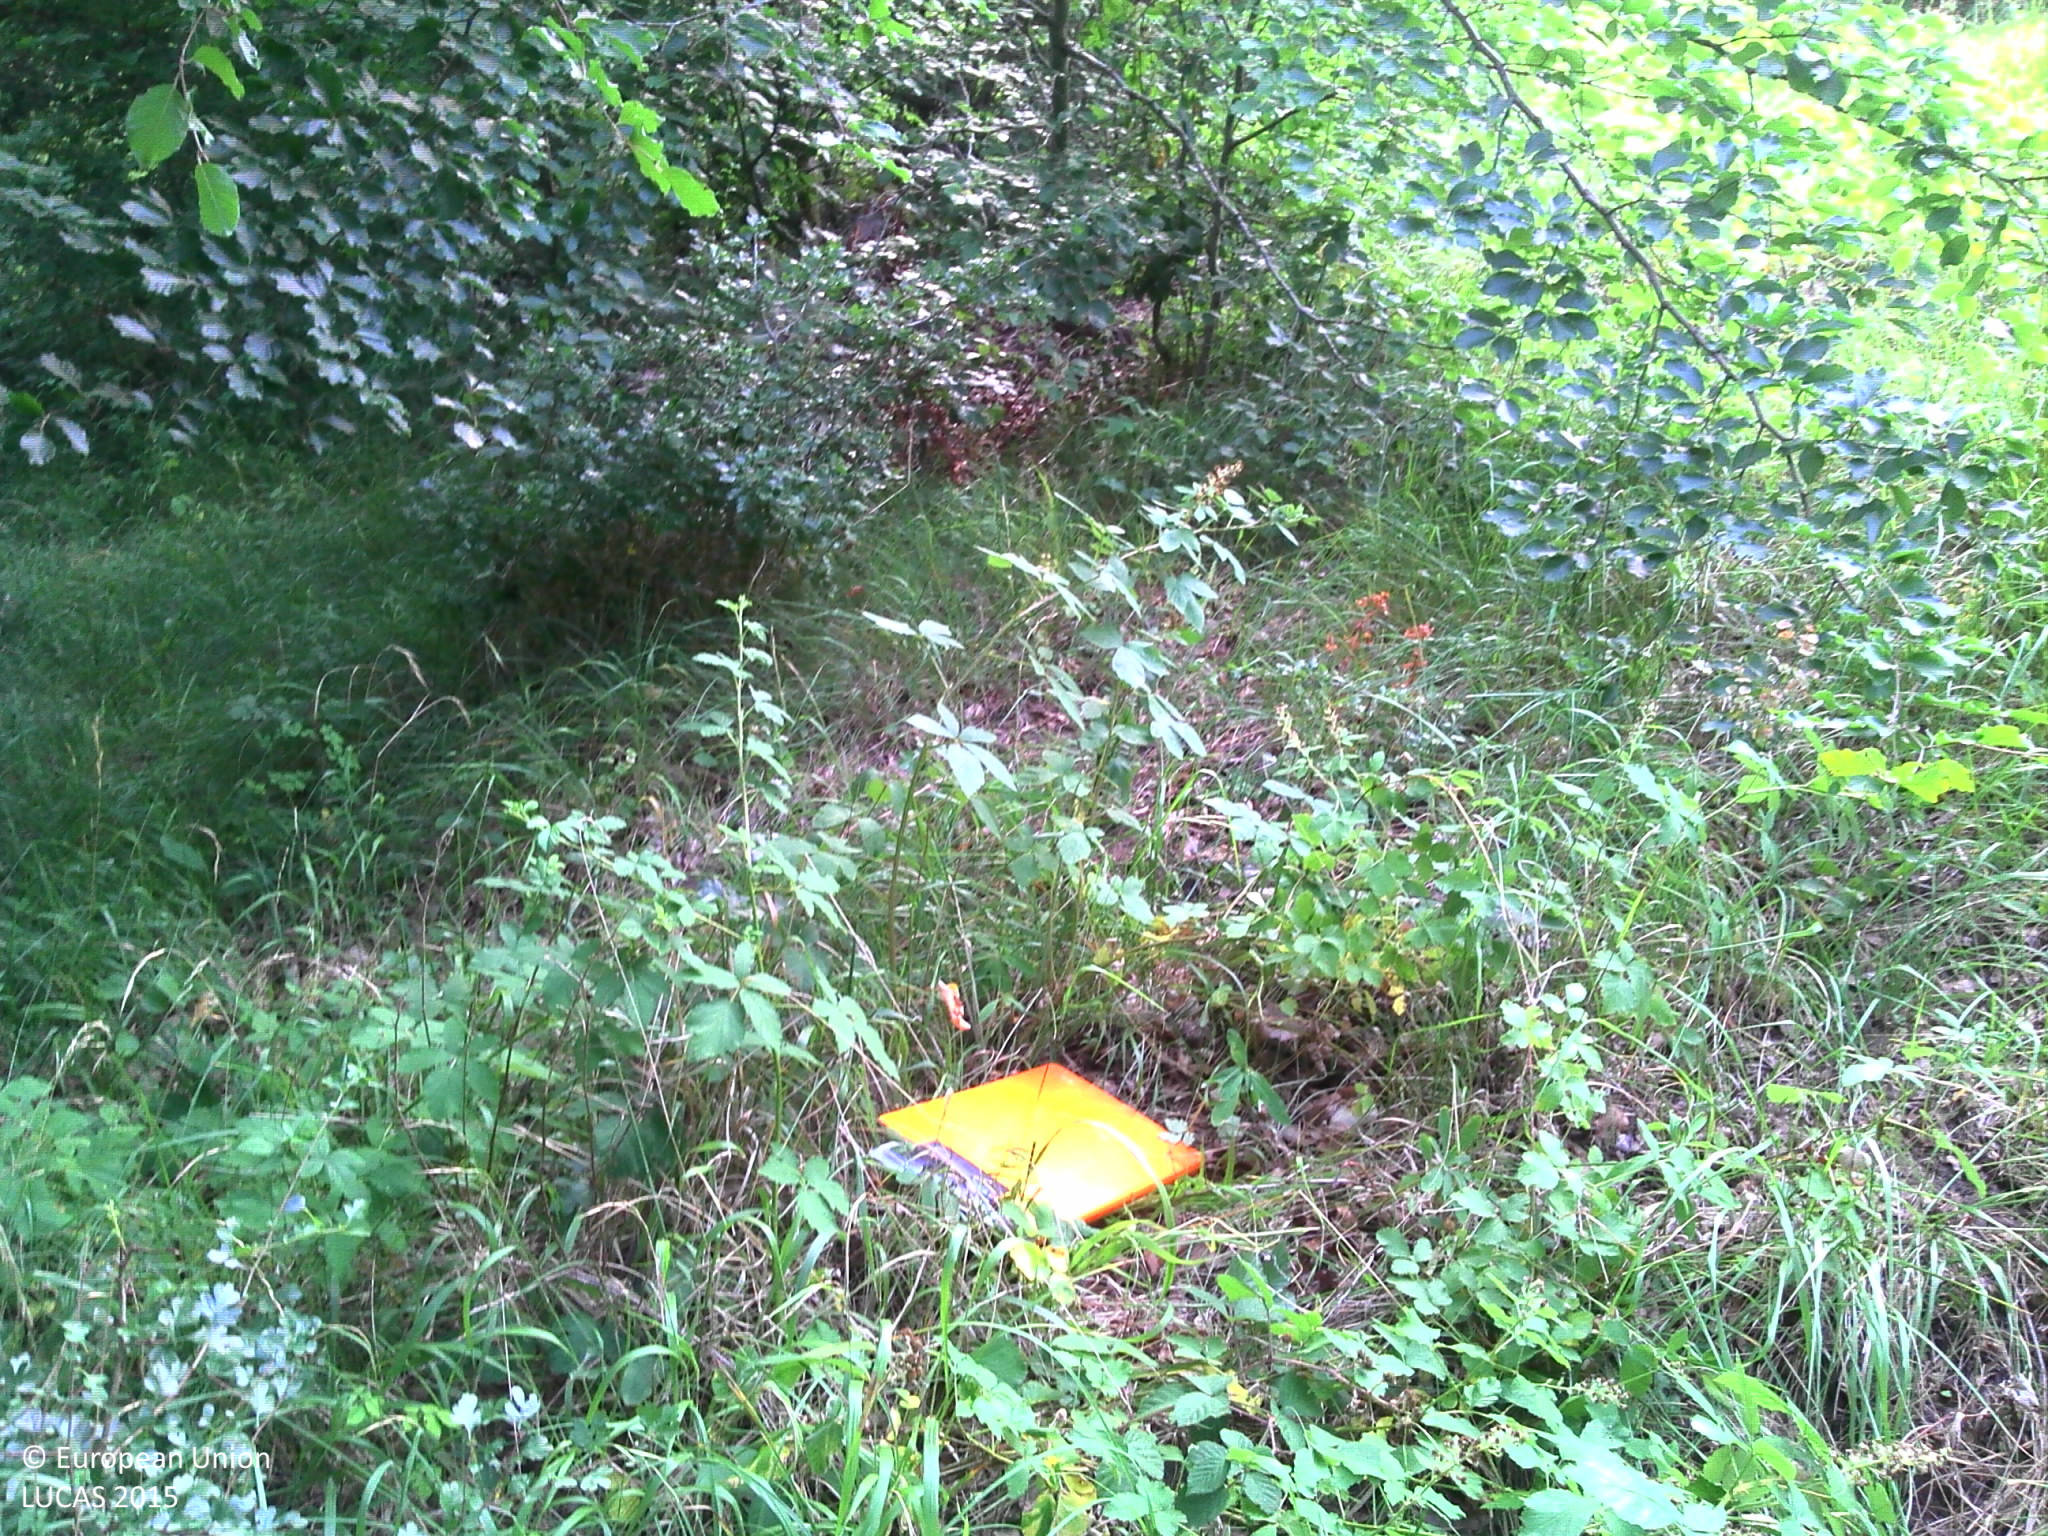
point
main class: Woodland
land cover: Broadleaved woodland
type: beech forest
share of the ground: > 75 %
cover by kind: broadleaved forest trees 80 %, herbaceous plants 15 %, lichens and mosses 5 %
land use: Forestry
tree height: > 5 m
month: July
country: FR
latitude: 48.1765
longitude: 4.8748
